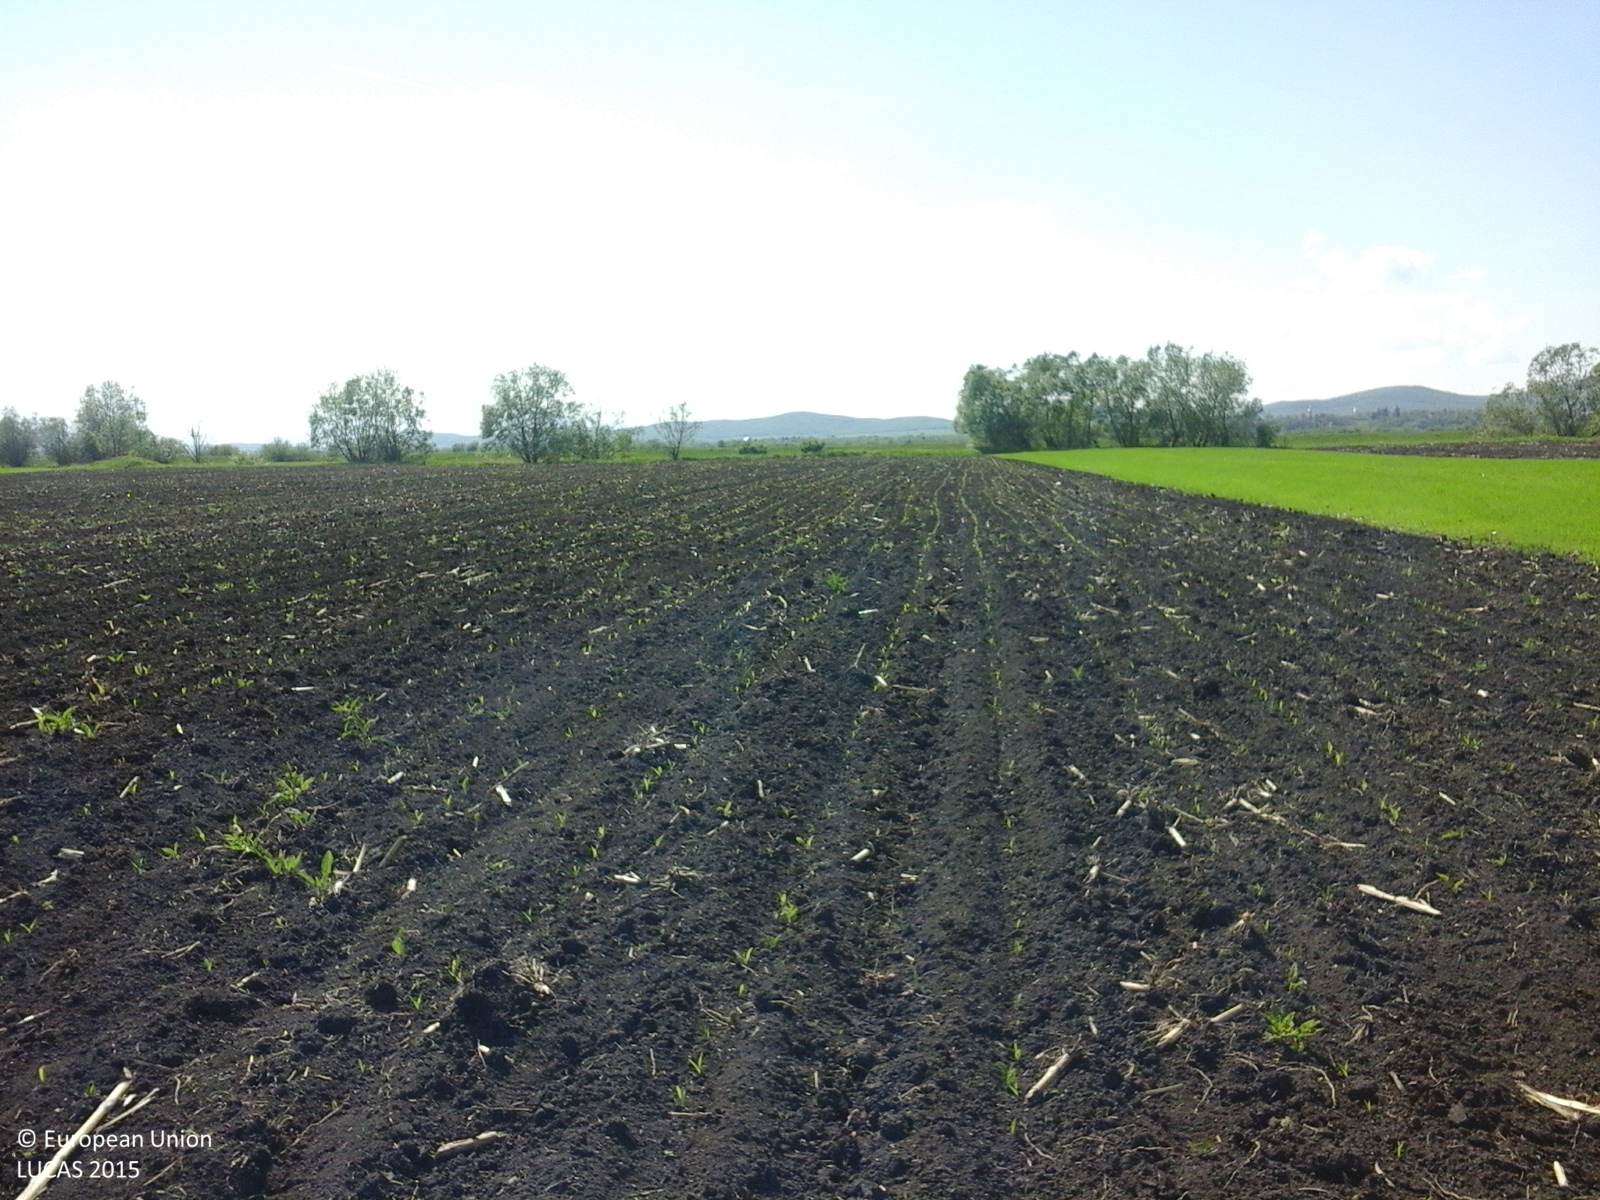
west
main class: Cropland
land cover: Maize
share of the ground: < 10 %
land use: Agriculture (excluding fallow land and kitchen gardens)
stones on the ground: < 10 %
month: May
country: RO
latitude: 45.7747
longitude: 25.7867
